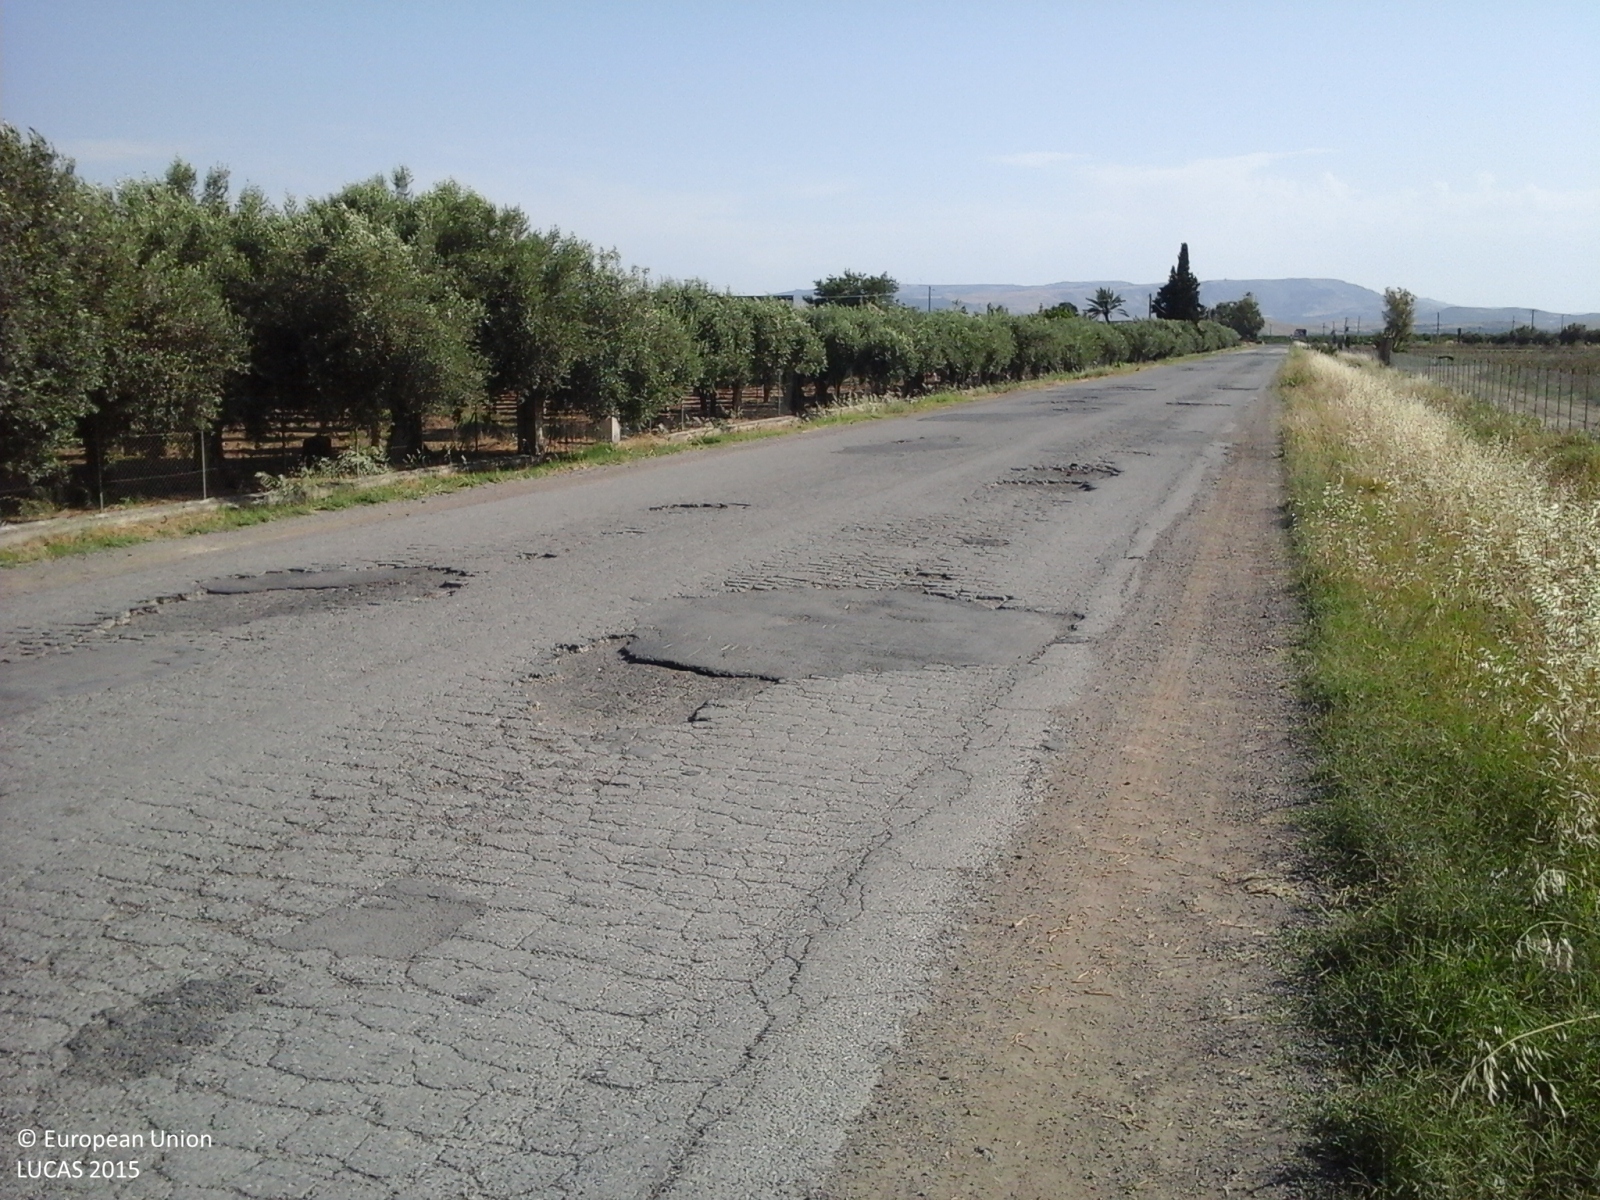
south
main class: Cropland
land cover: Common wheat
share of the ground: > 75 %
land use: Agriculture (excluding fallow land and kitchen gardens)
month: June
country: IT
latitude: 37.4064
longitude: 14.8336
